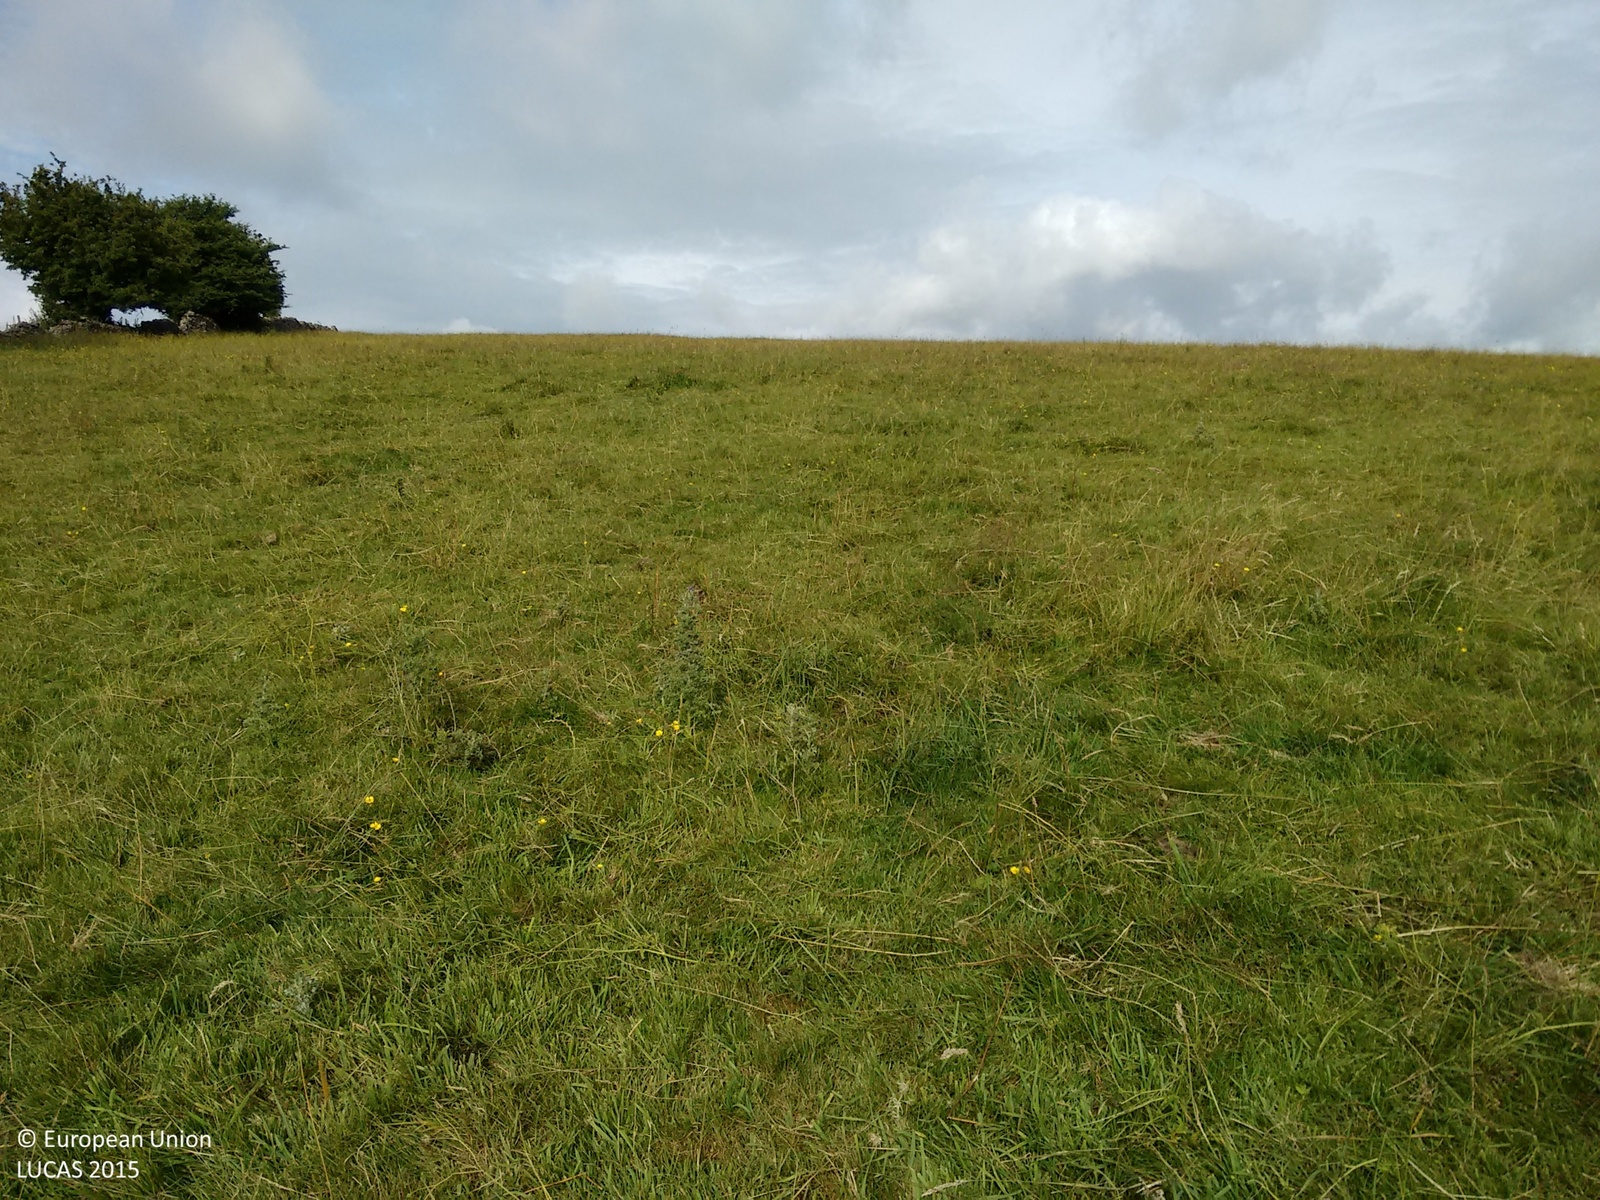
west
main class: Grassland
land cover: Grassland without tree/shrub cover
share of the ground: > 75 %
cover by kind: herbaceous plants 100 %
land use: Agriculture (excluding fallow land and kitchen gardens)
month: July
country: GB
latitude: 53.0793
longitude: -1.5911
